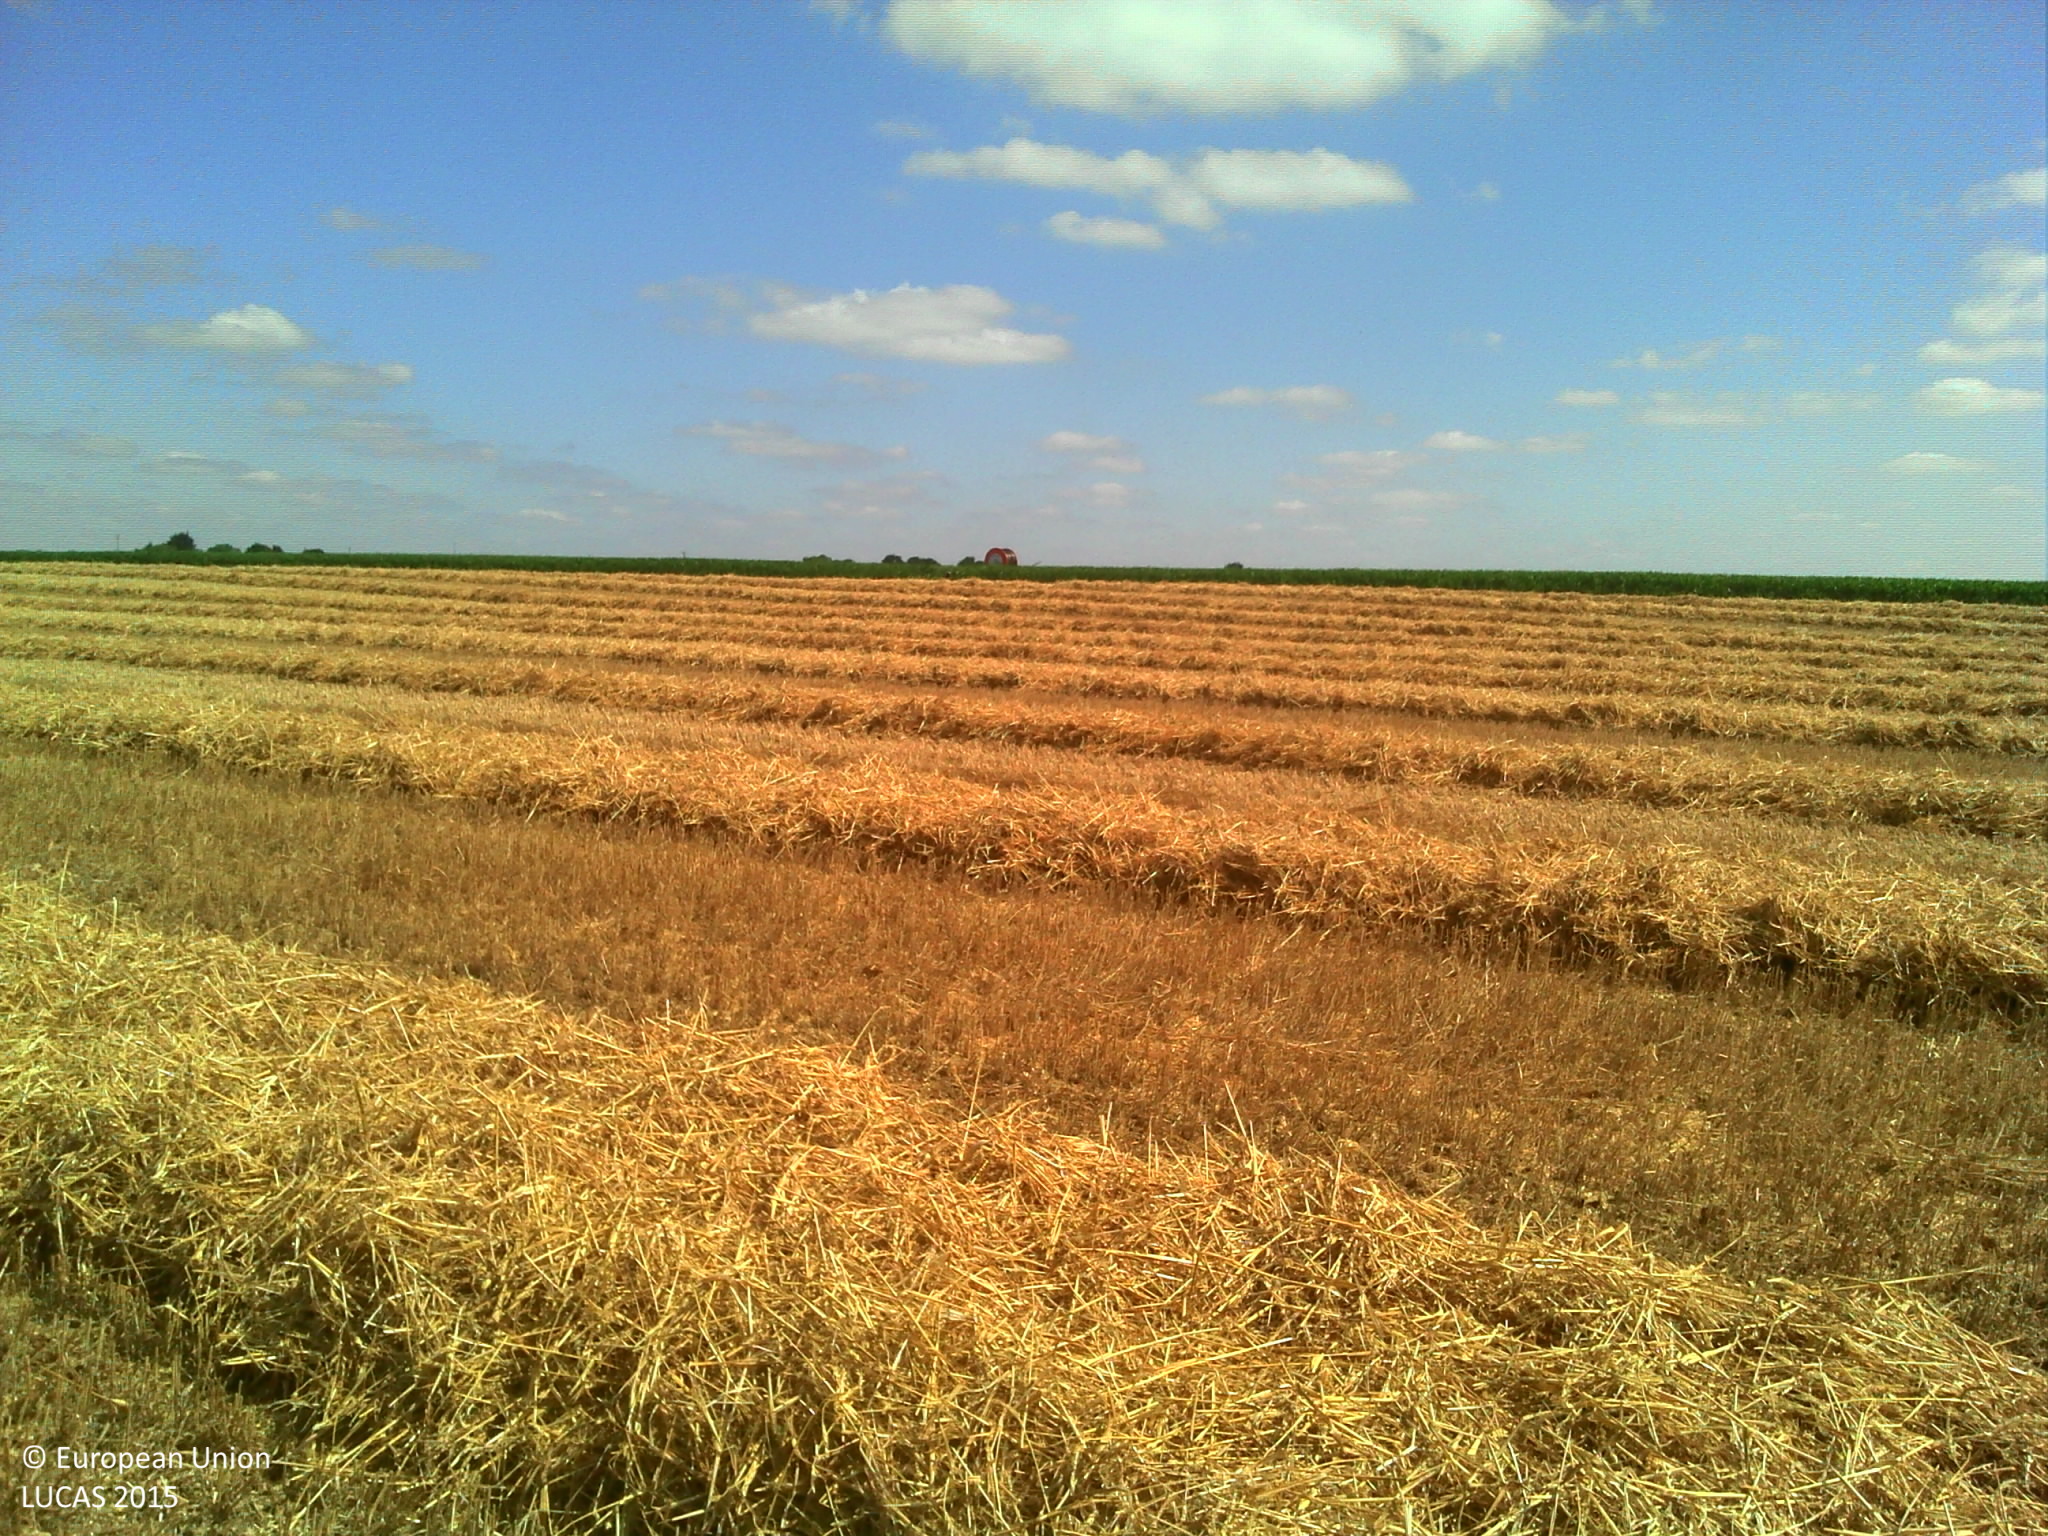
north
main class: Cropland
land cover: Common wheat
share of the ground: > 75 %
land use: Agriculture (excluding fallow land and kitchen gardens)
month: July
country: FR
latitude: 46.4158
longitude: -1.3676
